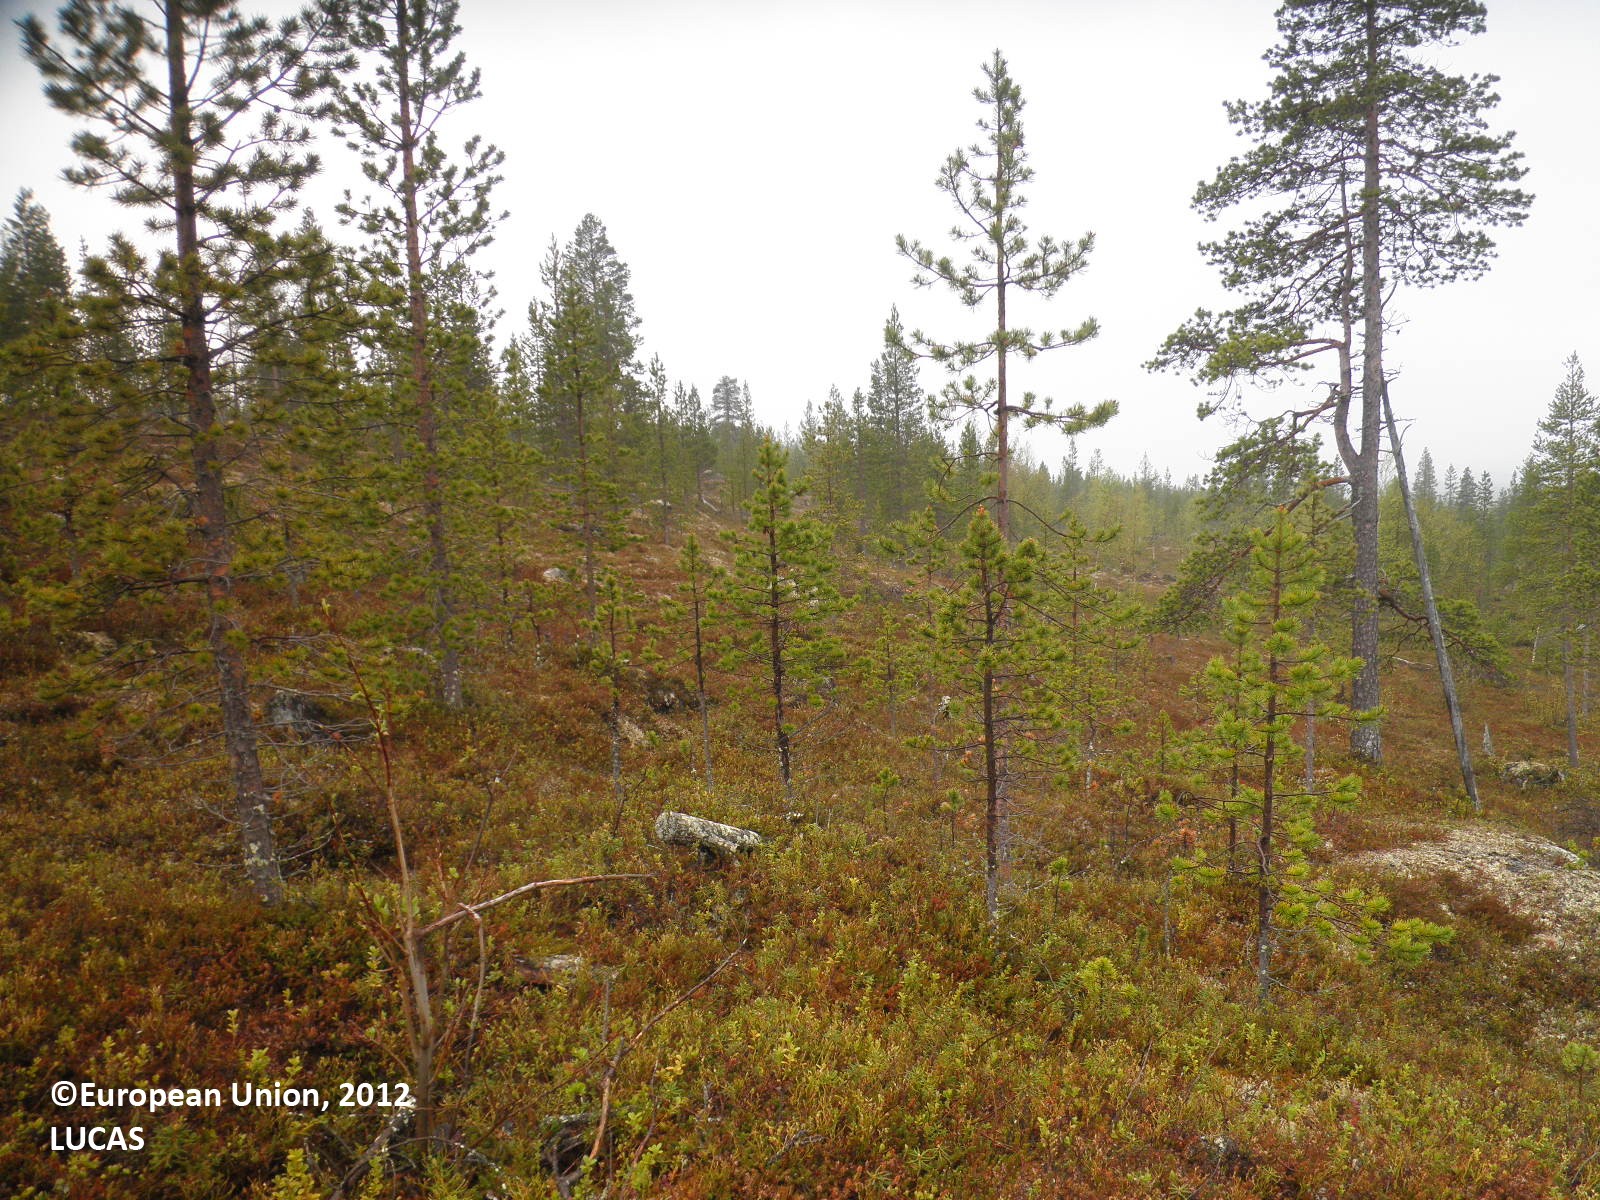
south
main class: Woodland
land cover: Pine dominated coniferous woodland
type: boreal forest
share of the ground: 10 - 25 %
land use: Forestry
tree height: > 5 m
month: June
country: FI
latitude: 69.0809
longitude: 27.2018
